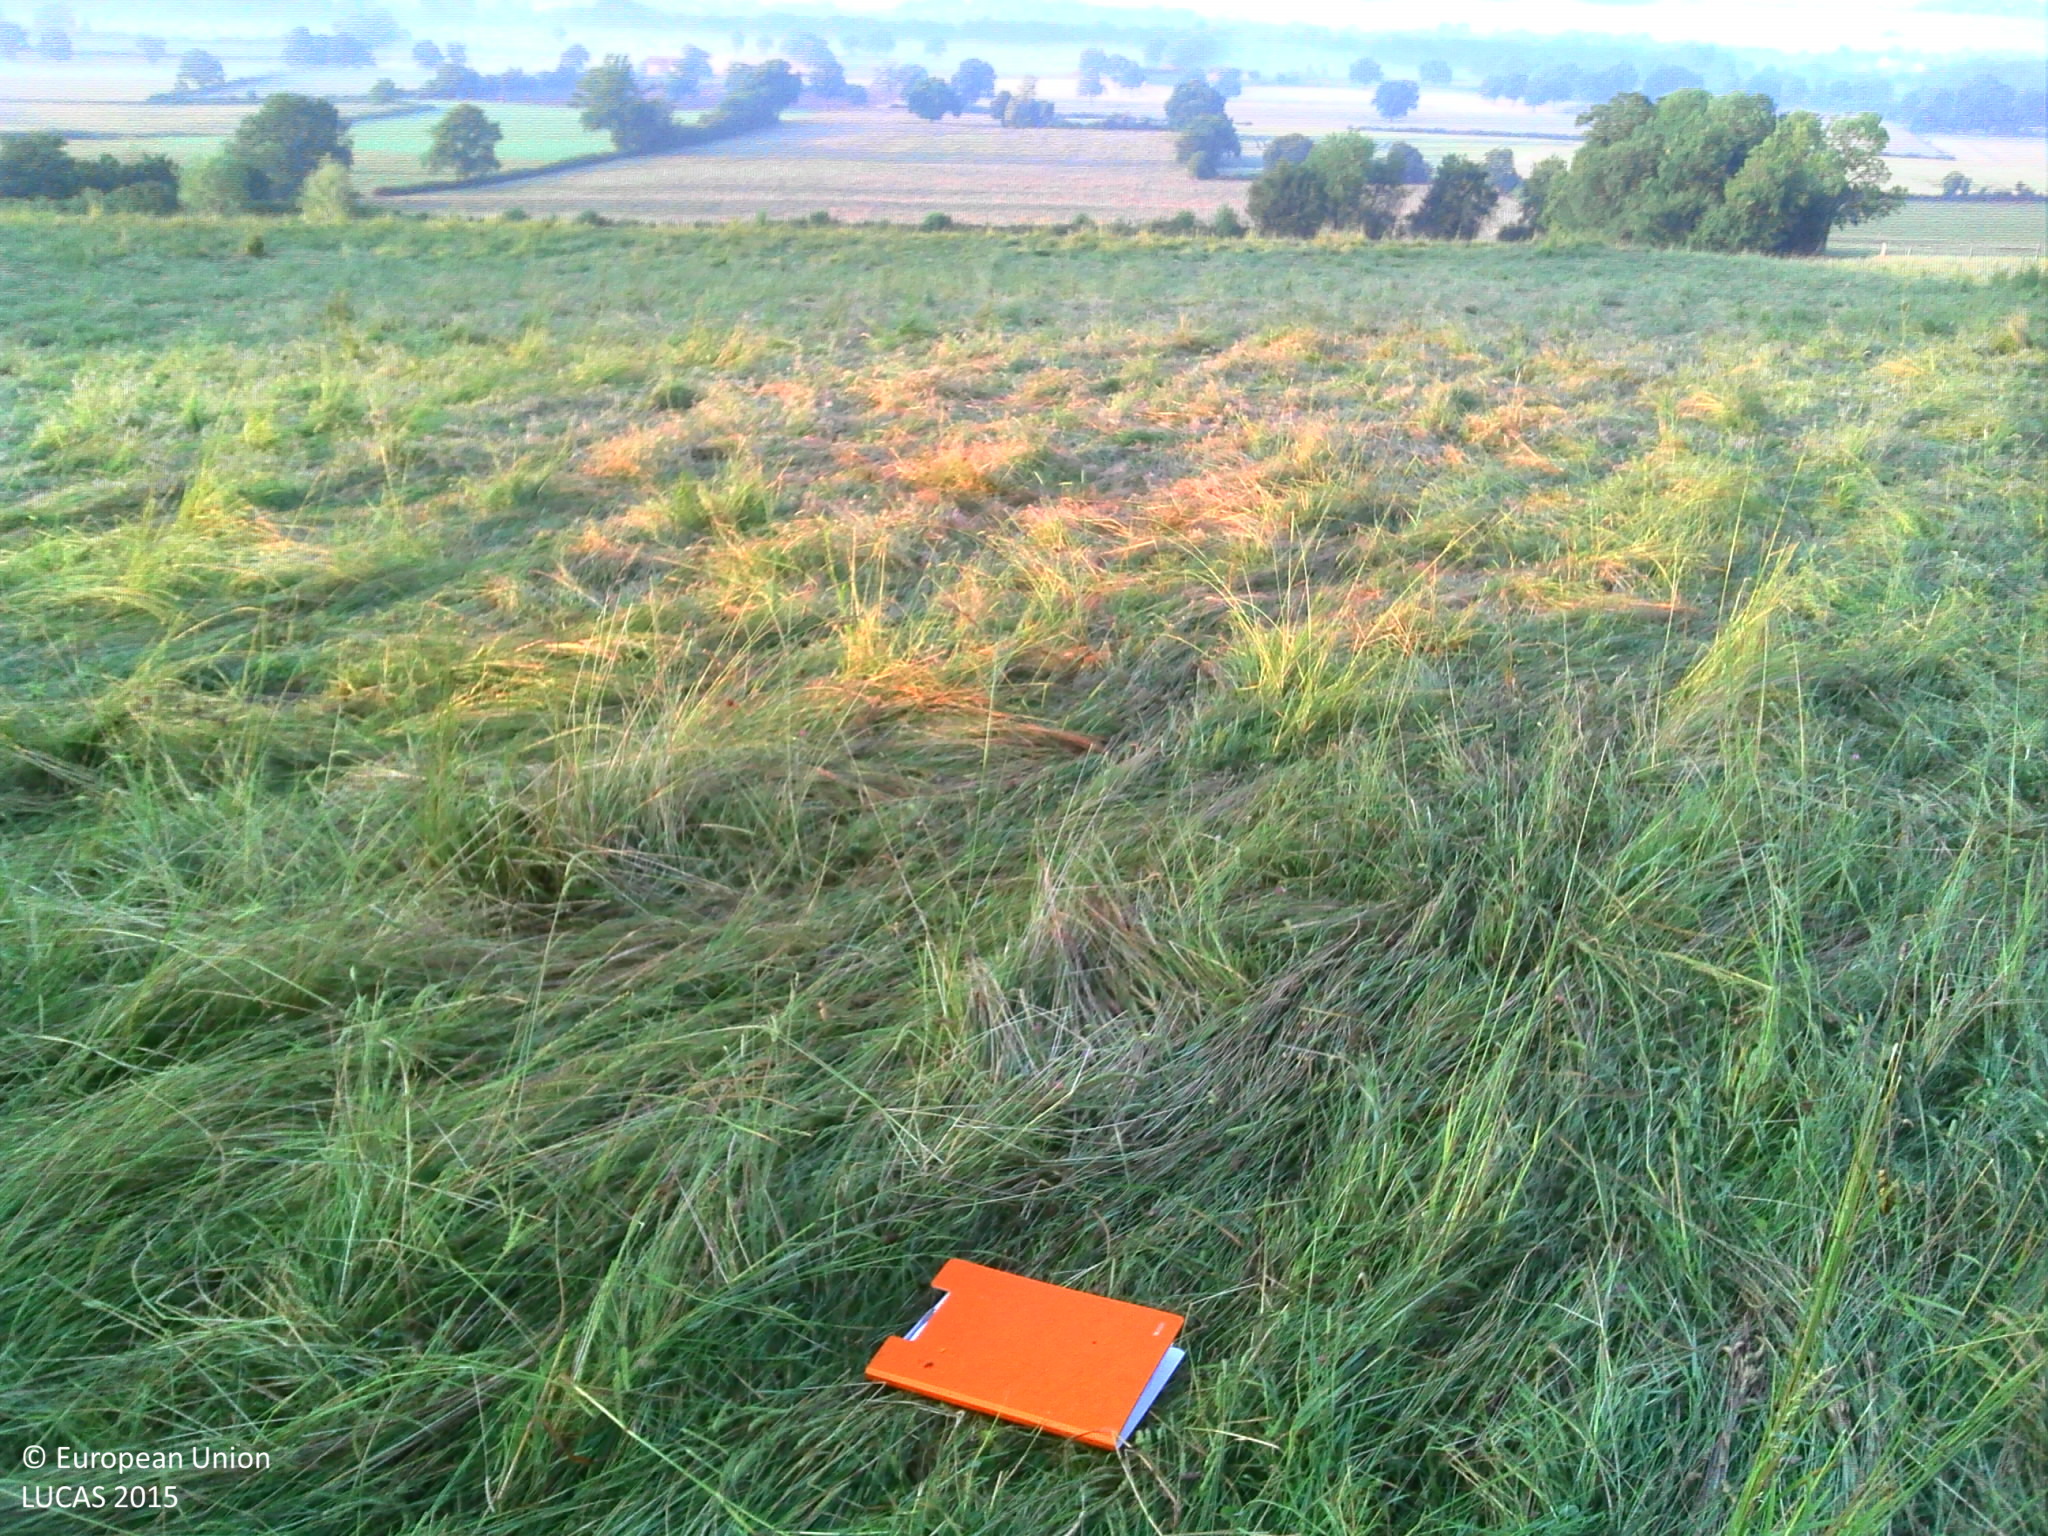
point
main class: Grassland
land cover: Grassland without tree/shrub cover
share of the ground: > 75 %
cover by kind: herbaceous plants 100 %
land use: Agriculture (excluding fallow land and kitchen gardens)
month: June
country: FR
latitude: 46.7492
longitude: 2.6514
